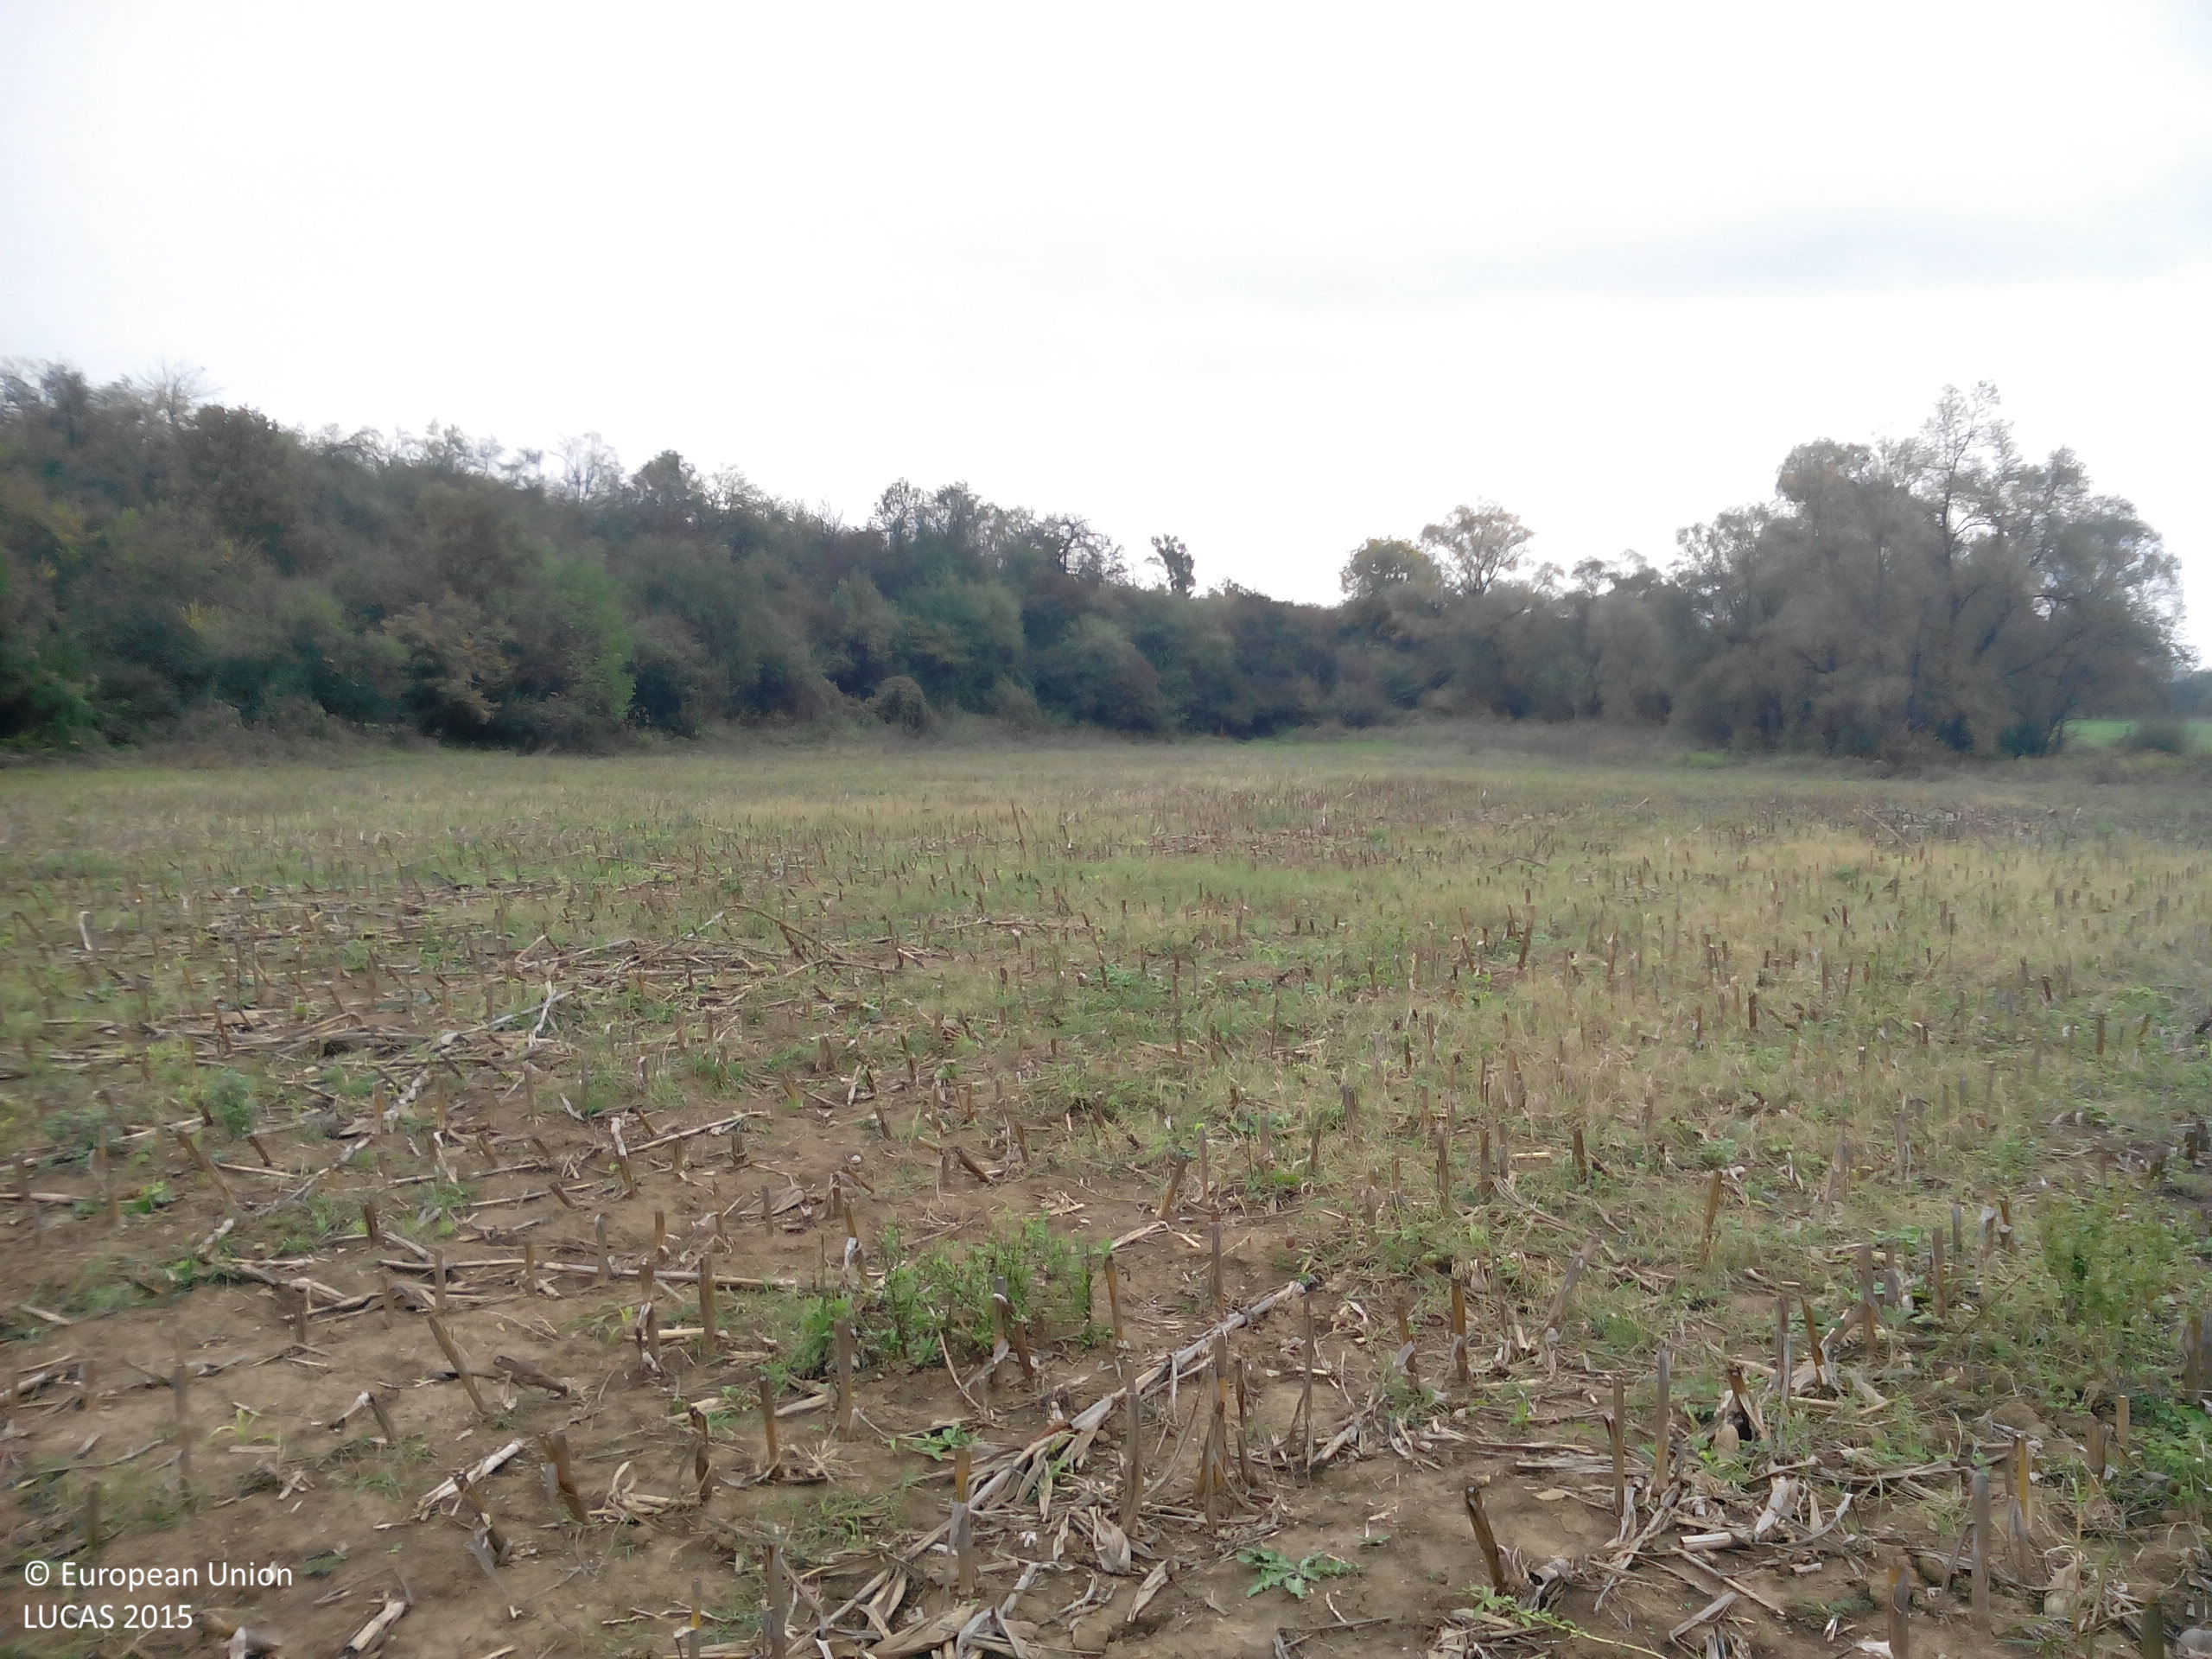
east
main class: Cropland
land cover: Maize
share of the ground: < 10 %
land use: Agriculture (excluding fallow land and kitchen gardens)
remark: Harvested field
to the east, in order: Maize; Shrubland with sparse tree cover; Broadleaved woodland; Shrubland with sparse tree cover; Common wheat
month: October
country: BG
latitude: 42.9912
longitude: 24.0178
